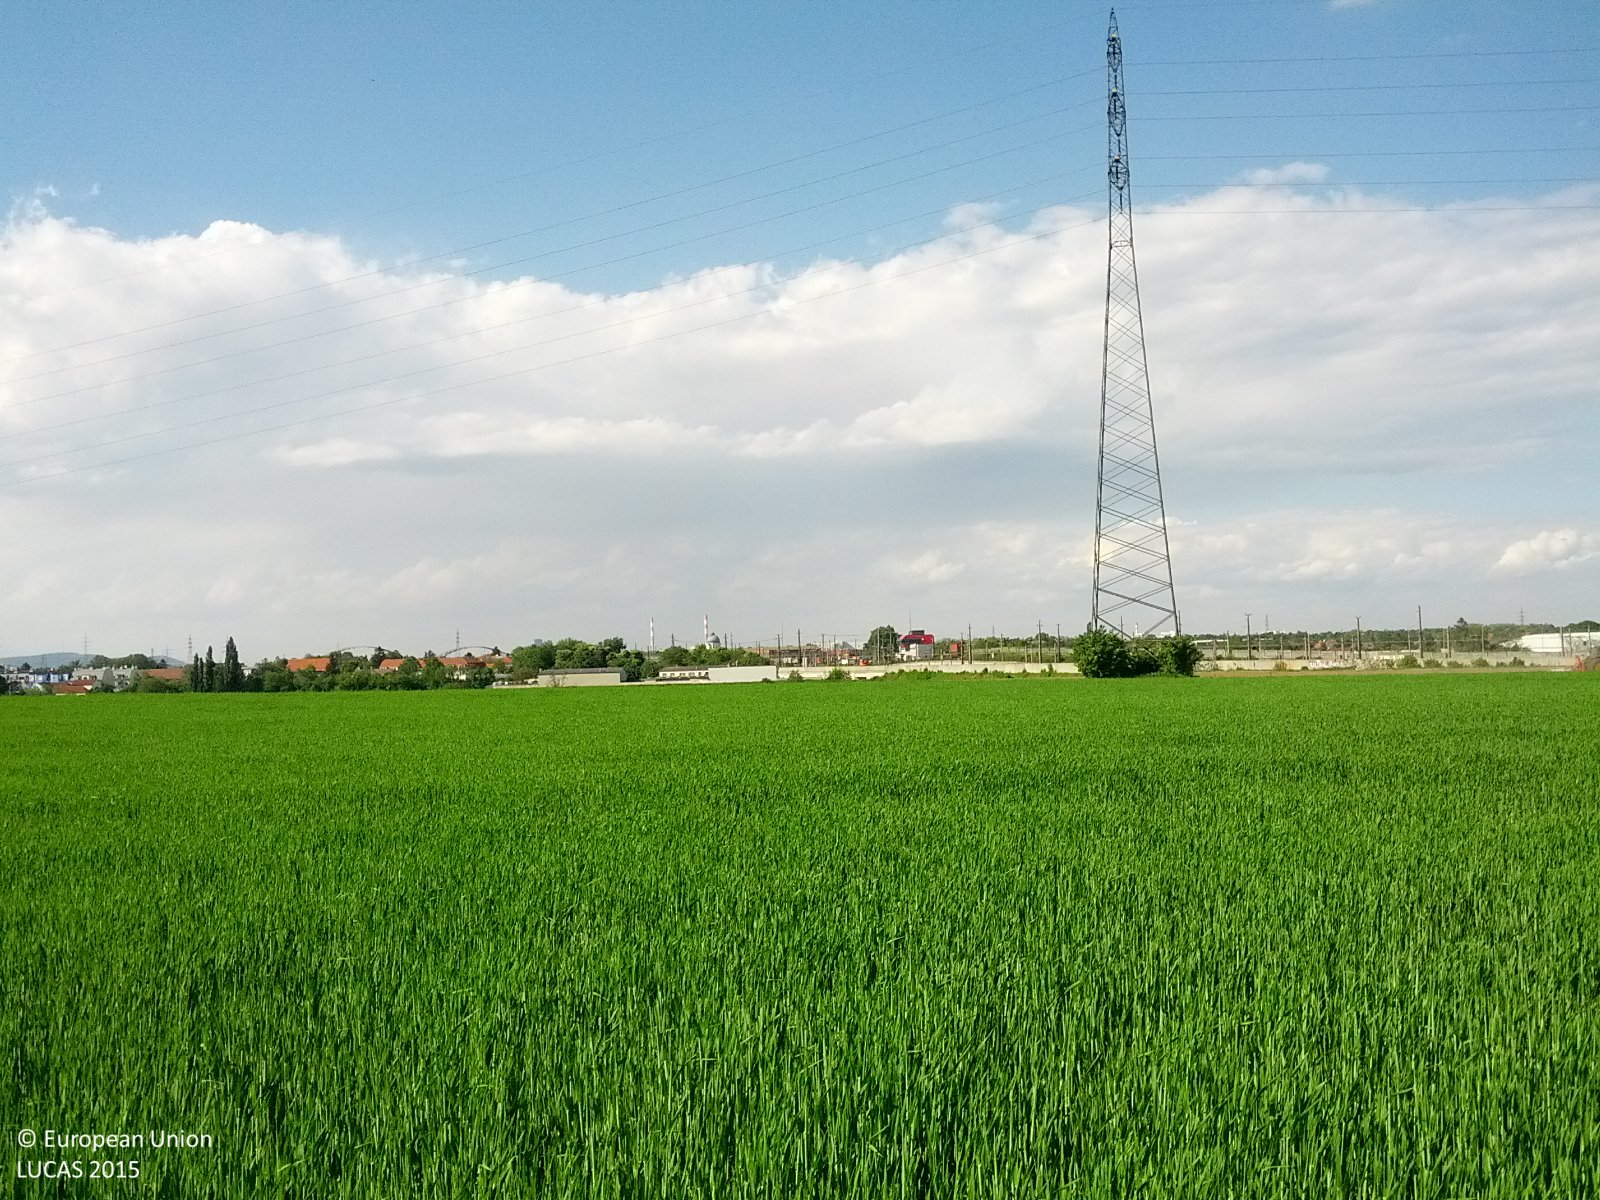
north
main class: Cropland
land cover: Lucerne
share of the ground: 50 - 75 %
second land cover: Other leguminous and mixtures for fodder
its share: 50 - 75 %
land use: Agriculture (excluding fallow land and kitchen gardens)
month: May
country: AT
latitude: 48.1254
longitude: 16.4405
